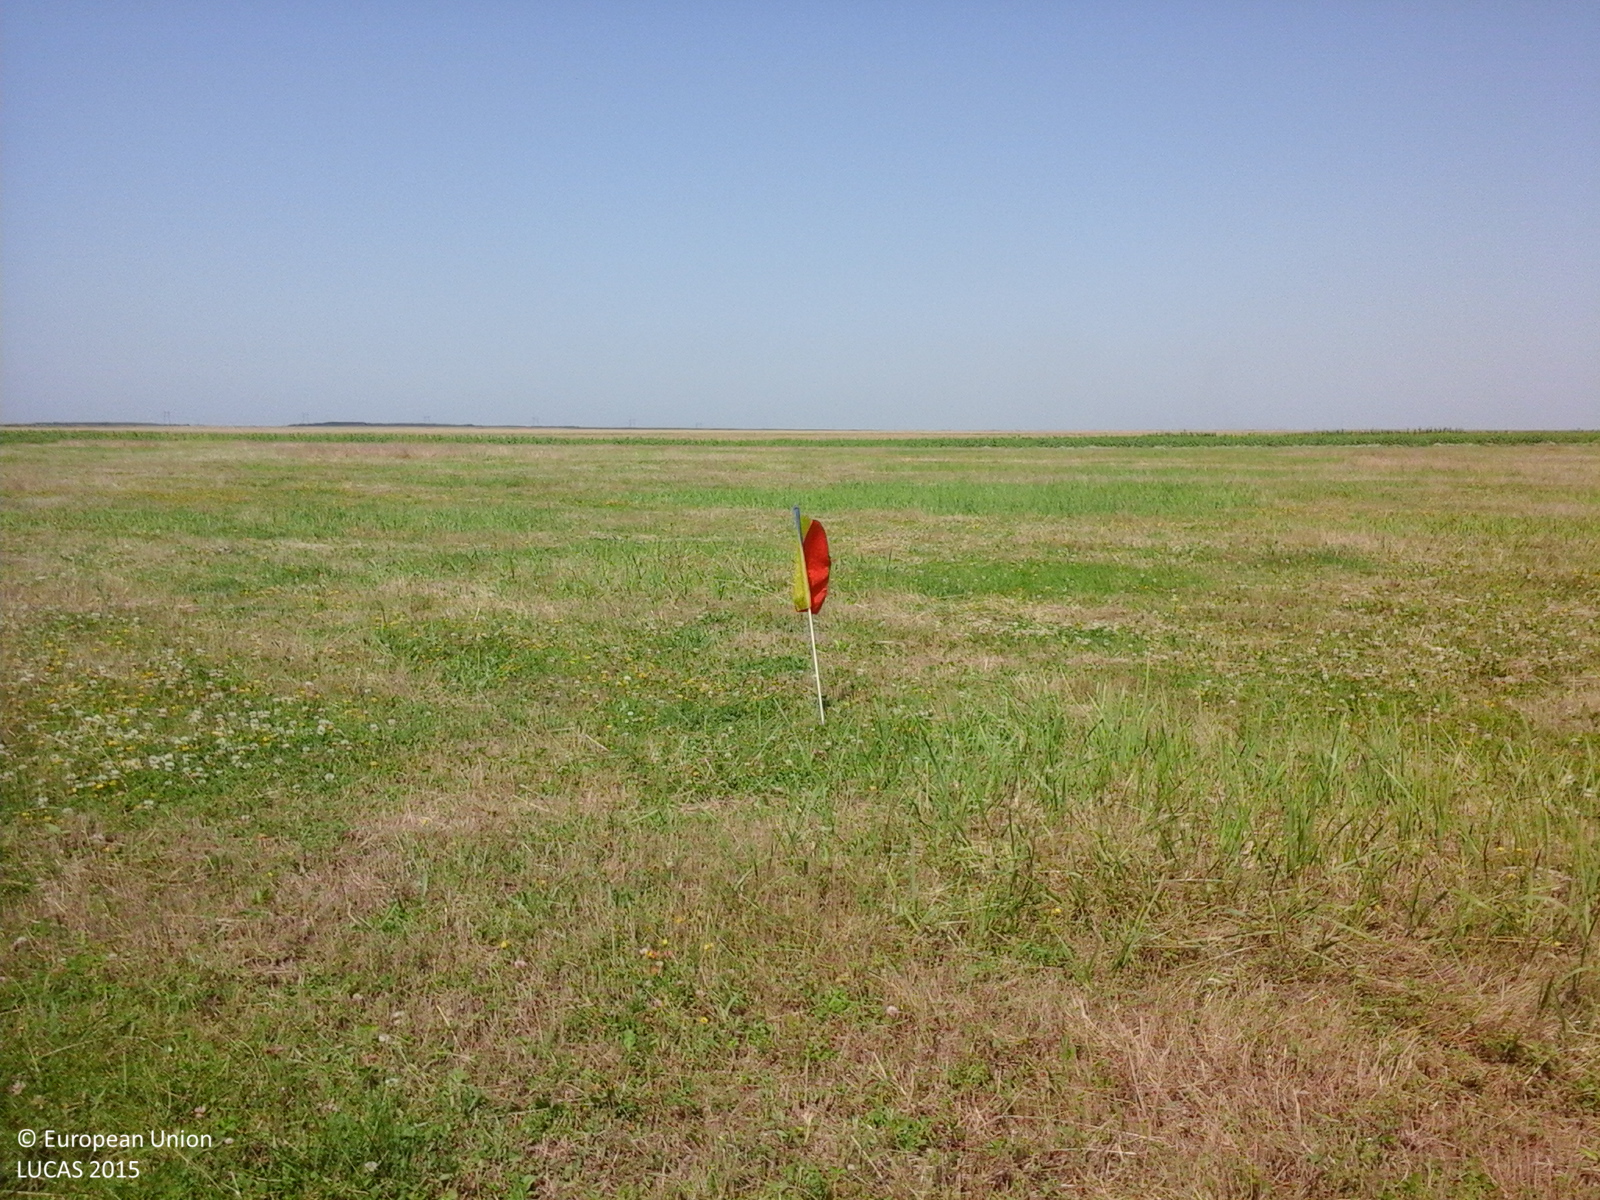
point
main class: Grassland
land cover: Grassland without tree/shrub cover
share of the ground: > 75 %
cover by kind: herbaceous plants 100 %
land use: Agriculture (excluding fallow land and kitchen gardens)
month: July
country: RO
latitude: 44.3847
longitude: 24.5180
